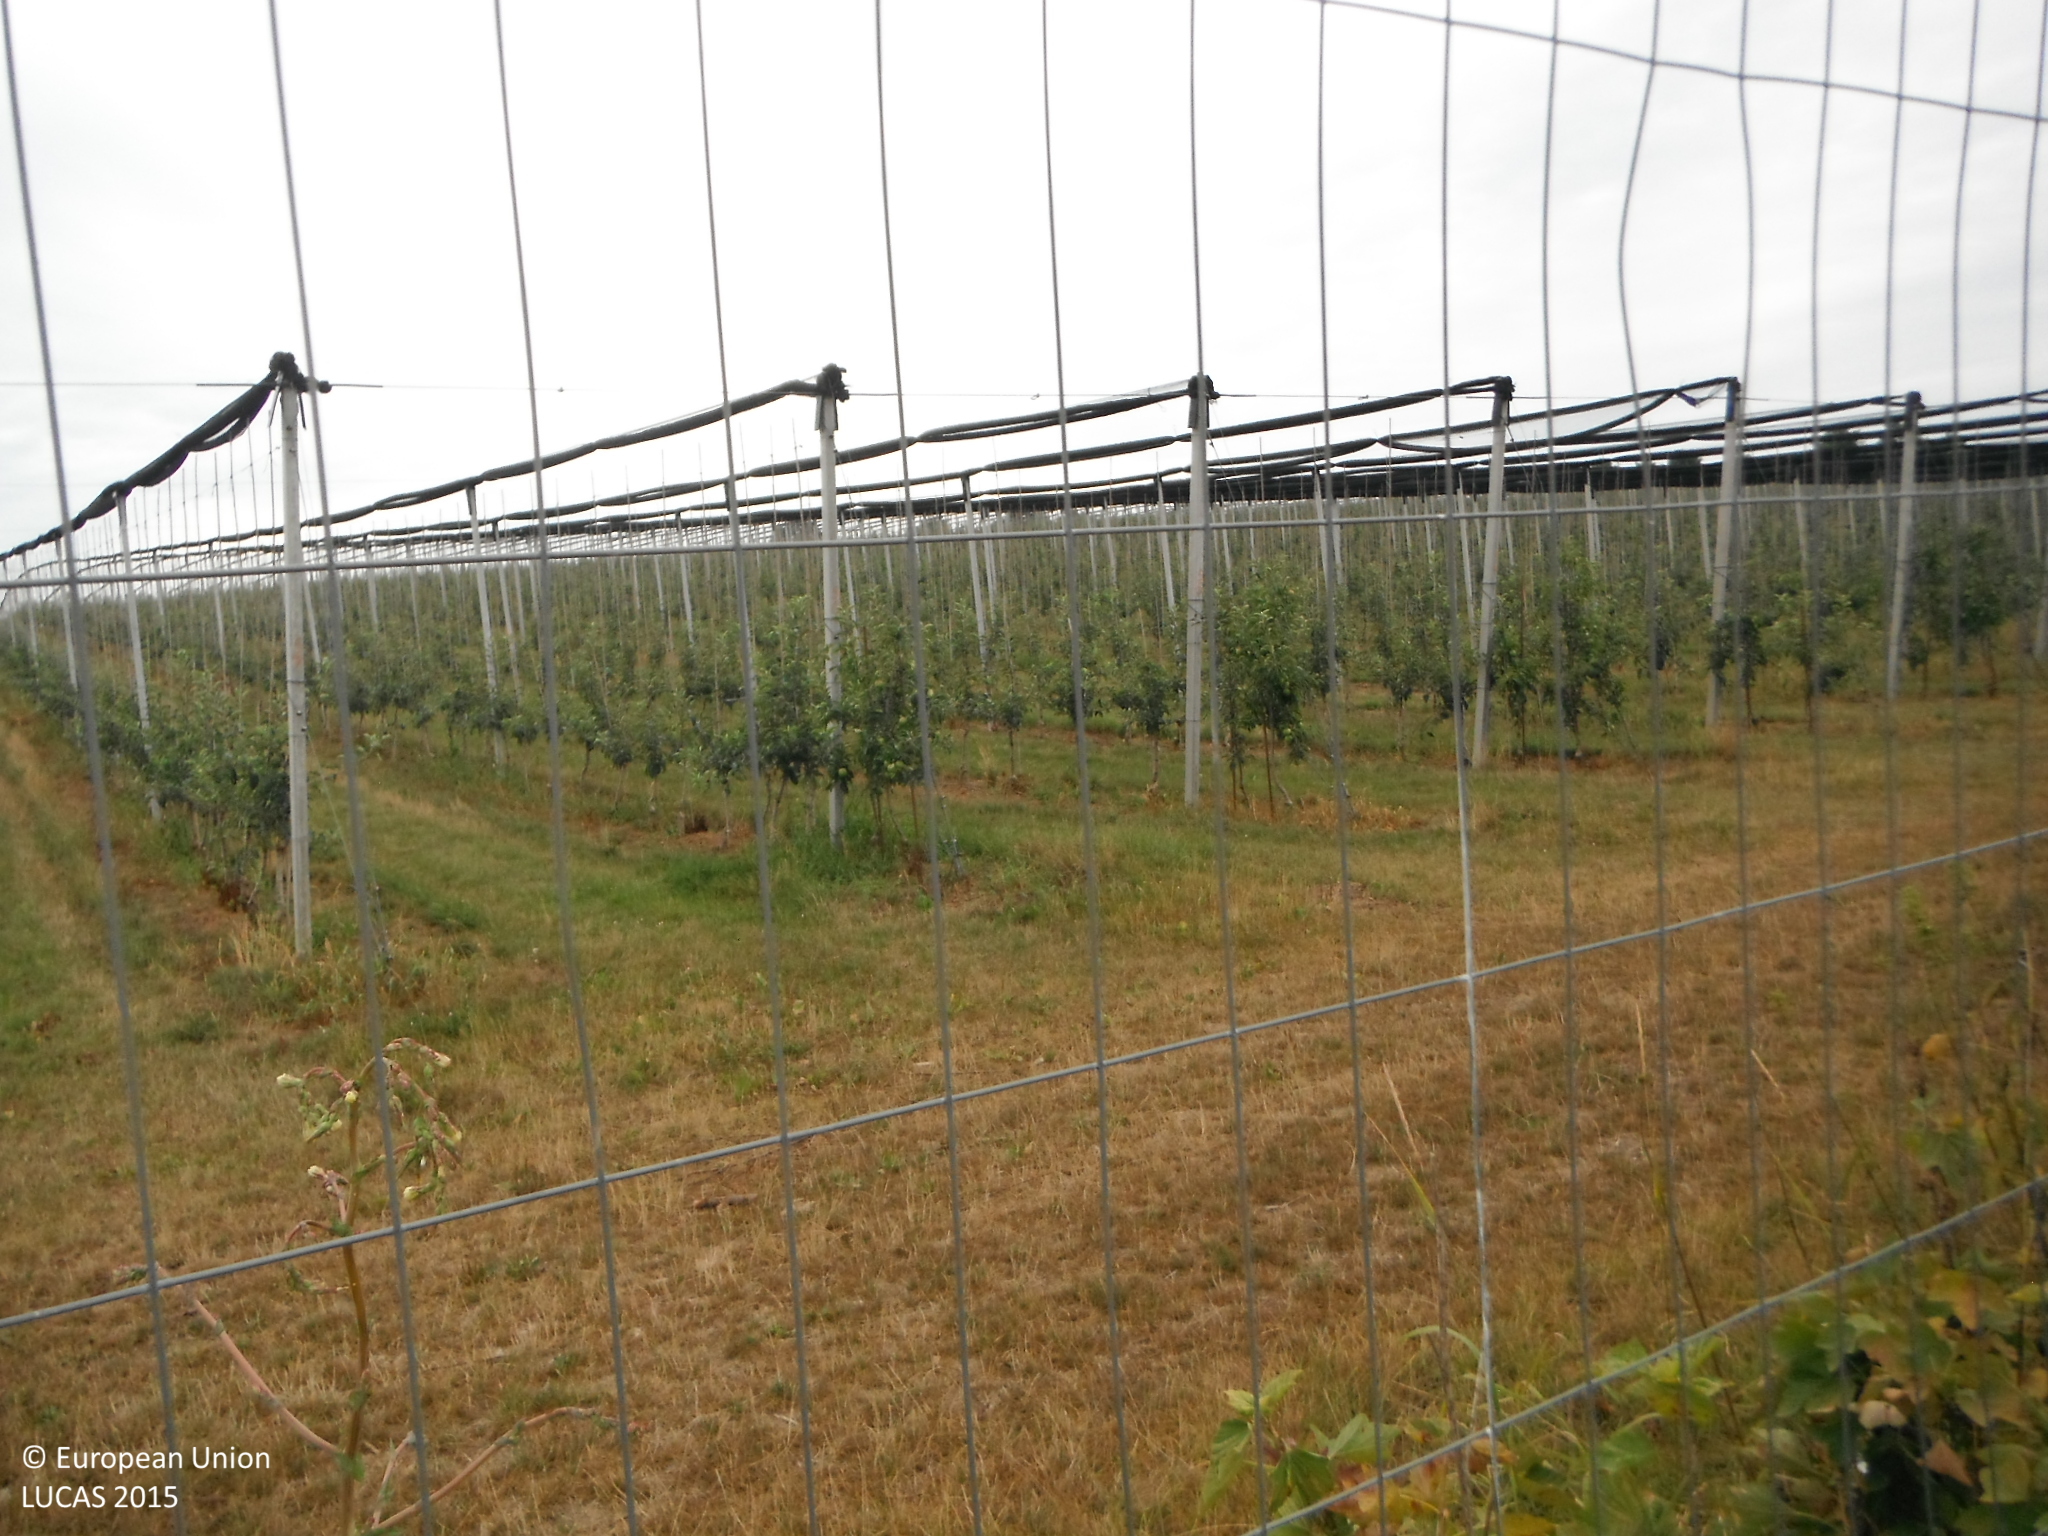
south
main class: Cropland
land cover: Permanent crops (only in case pi)
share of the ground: 50 - 75 %
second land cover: Grassland without tree/shrub cover
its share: > 75 %
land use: Agriculture (excluding fallow land and kitchen gardens)
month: July
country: SK
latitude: 48.6510
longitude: 18.3096
